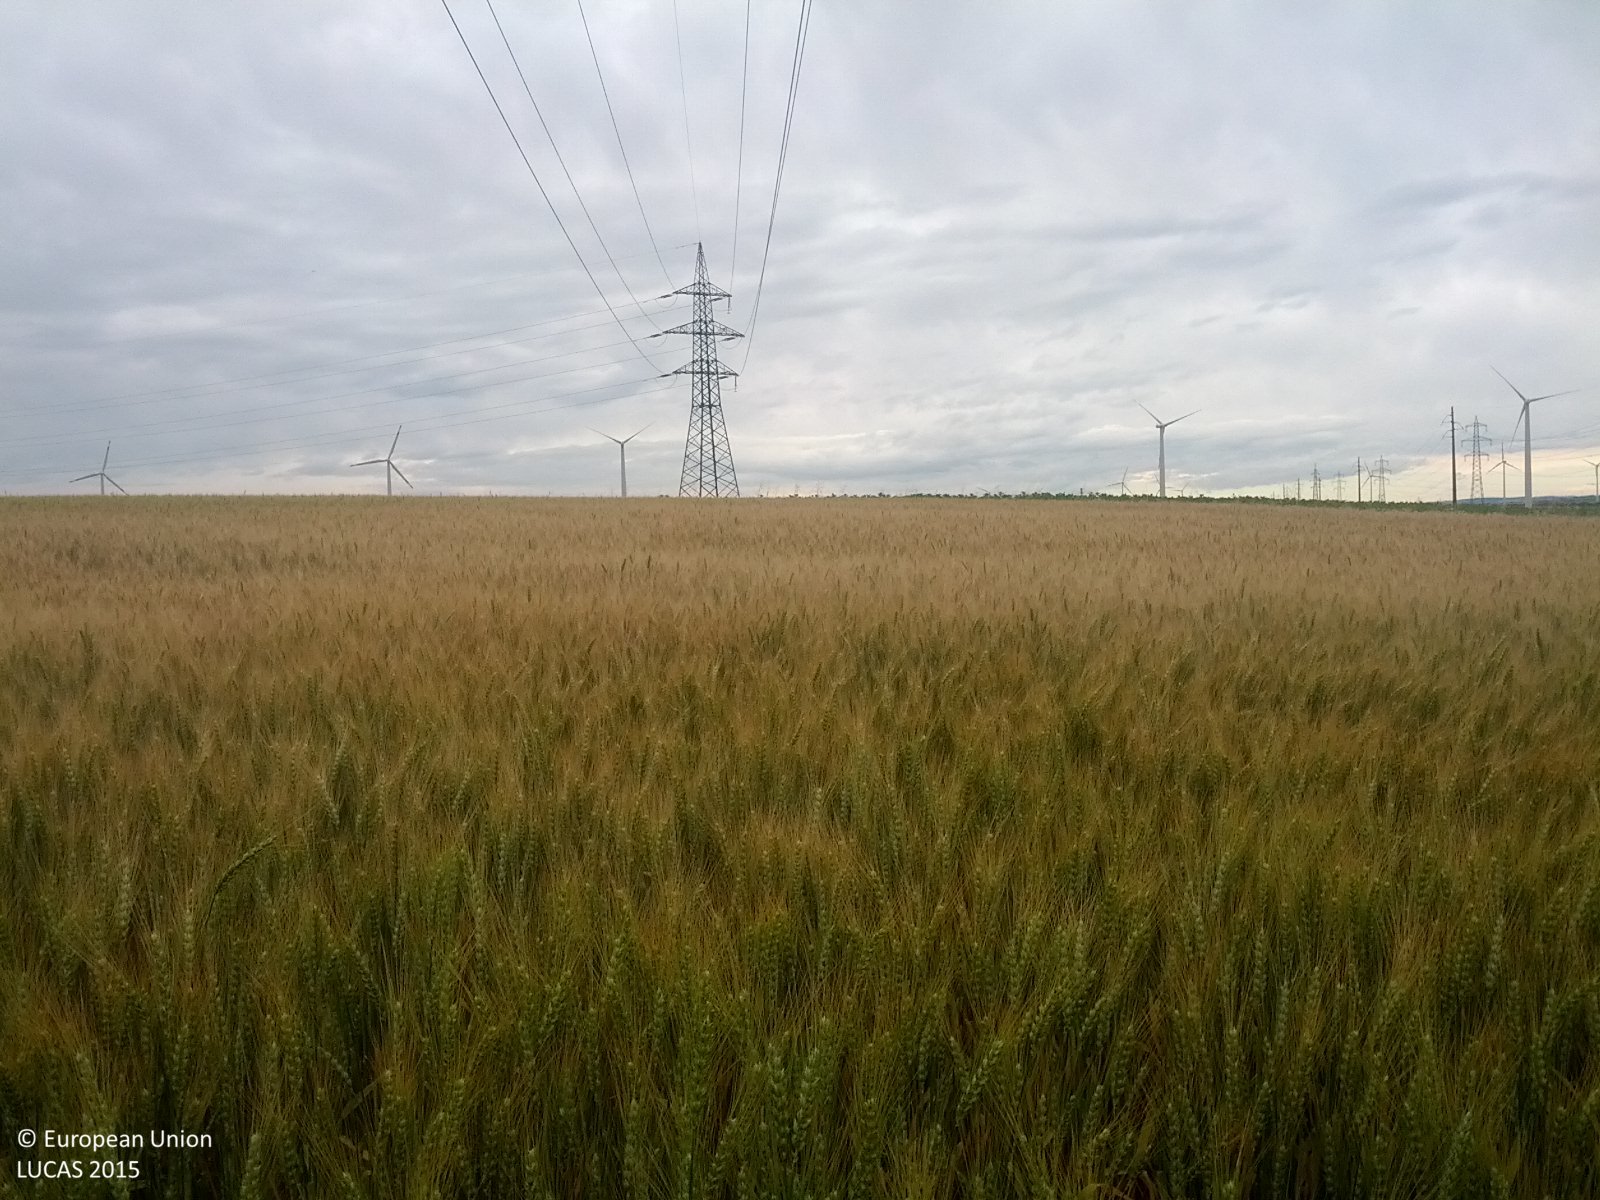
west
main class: Cropland
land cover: Common wheat
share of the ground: > 75 %
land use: Agriculture (excluding fallow land and kitchen gardens)
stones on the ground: 25 - 50 %
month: June
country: AT
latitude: 48.3439
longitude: 16.7123
